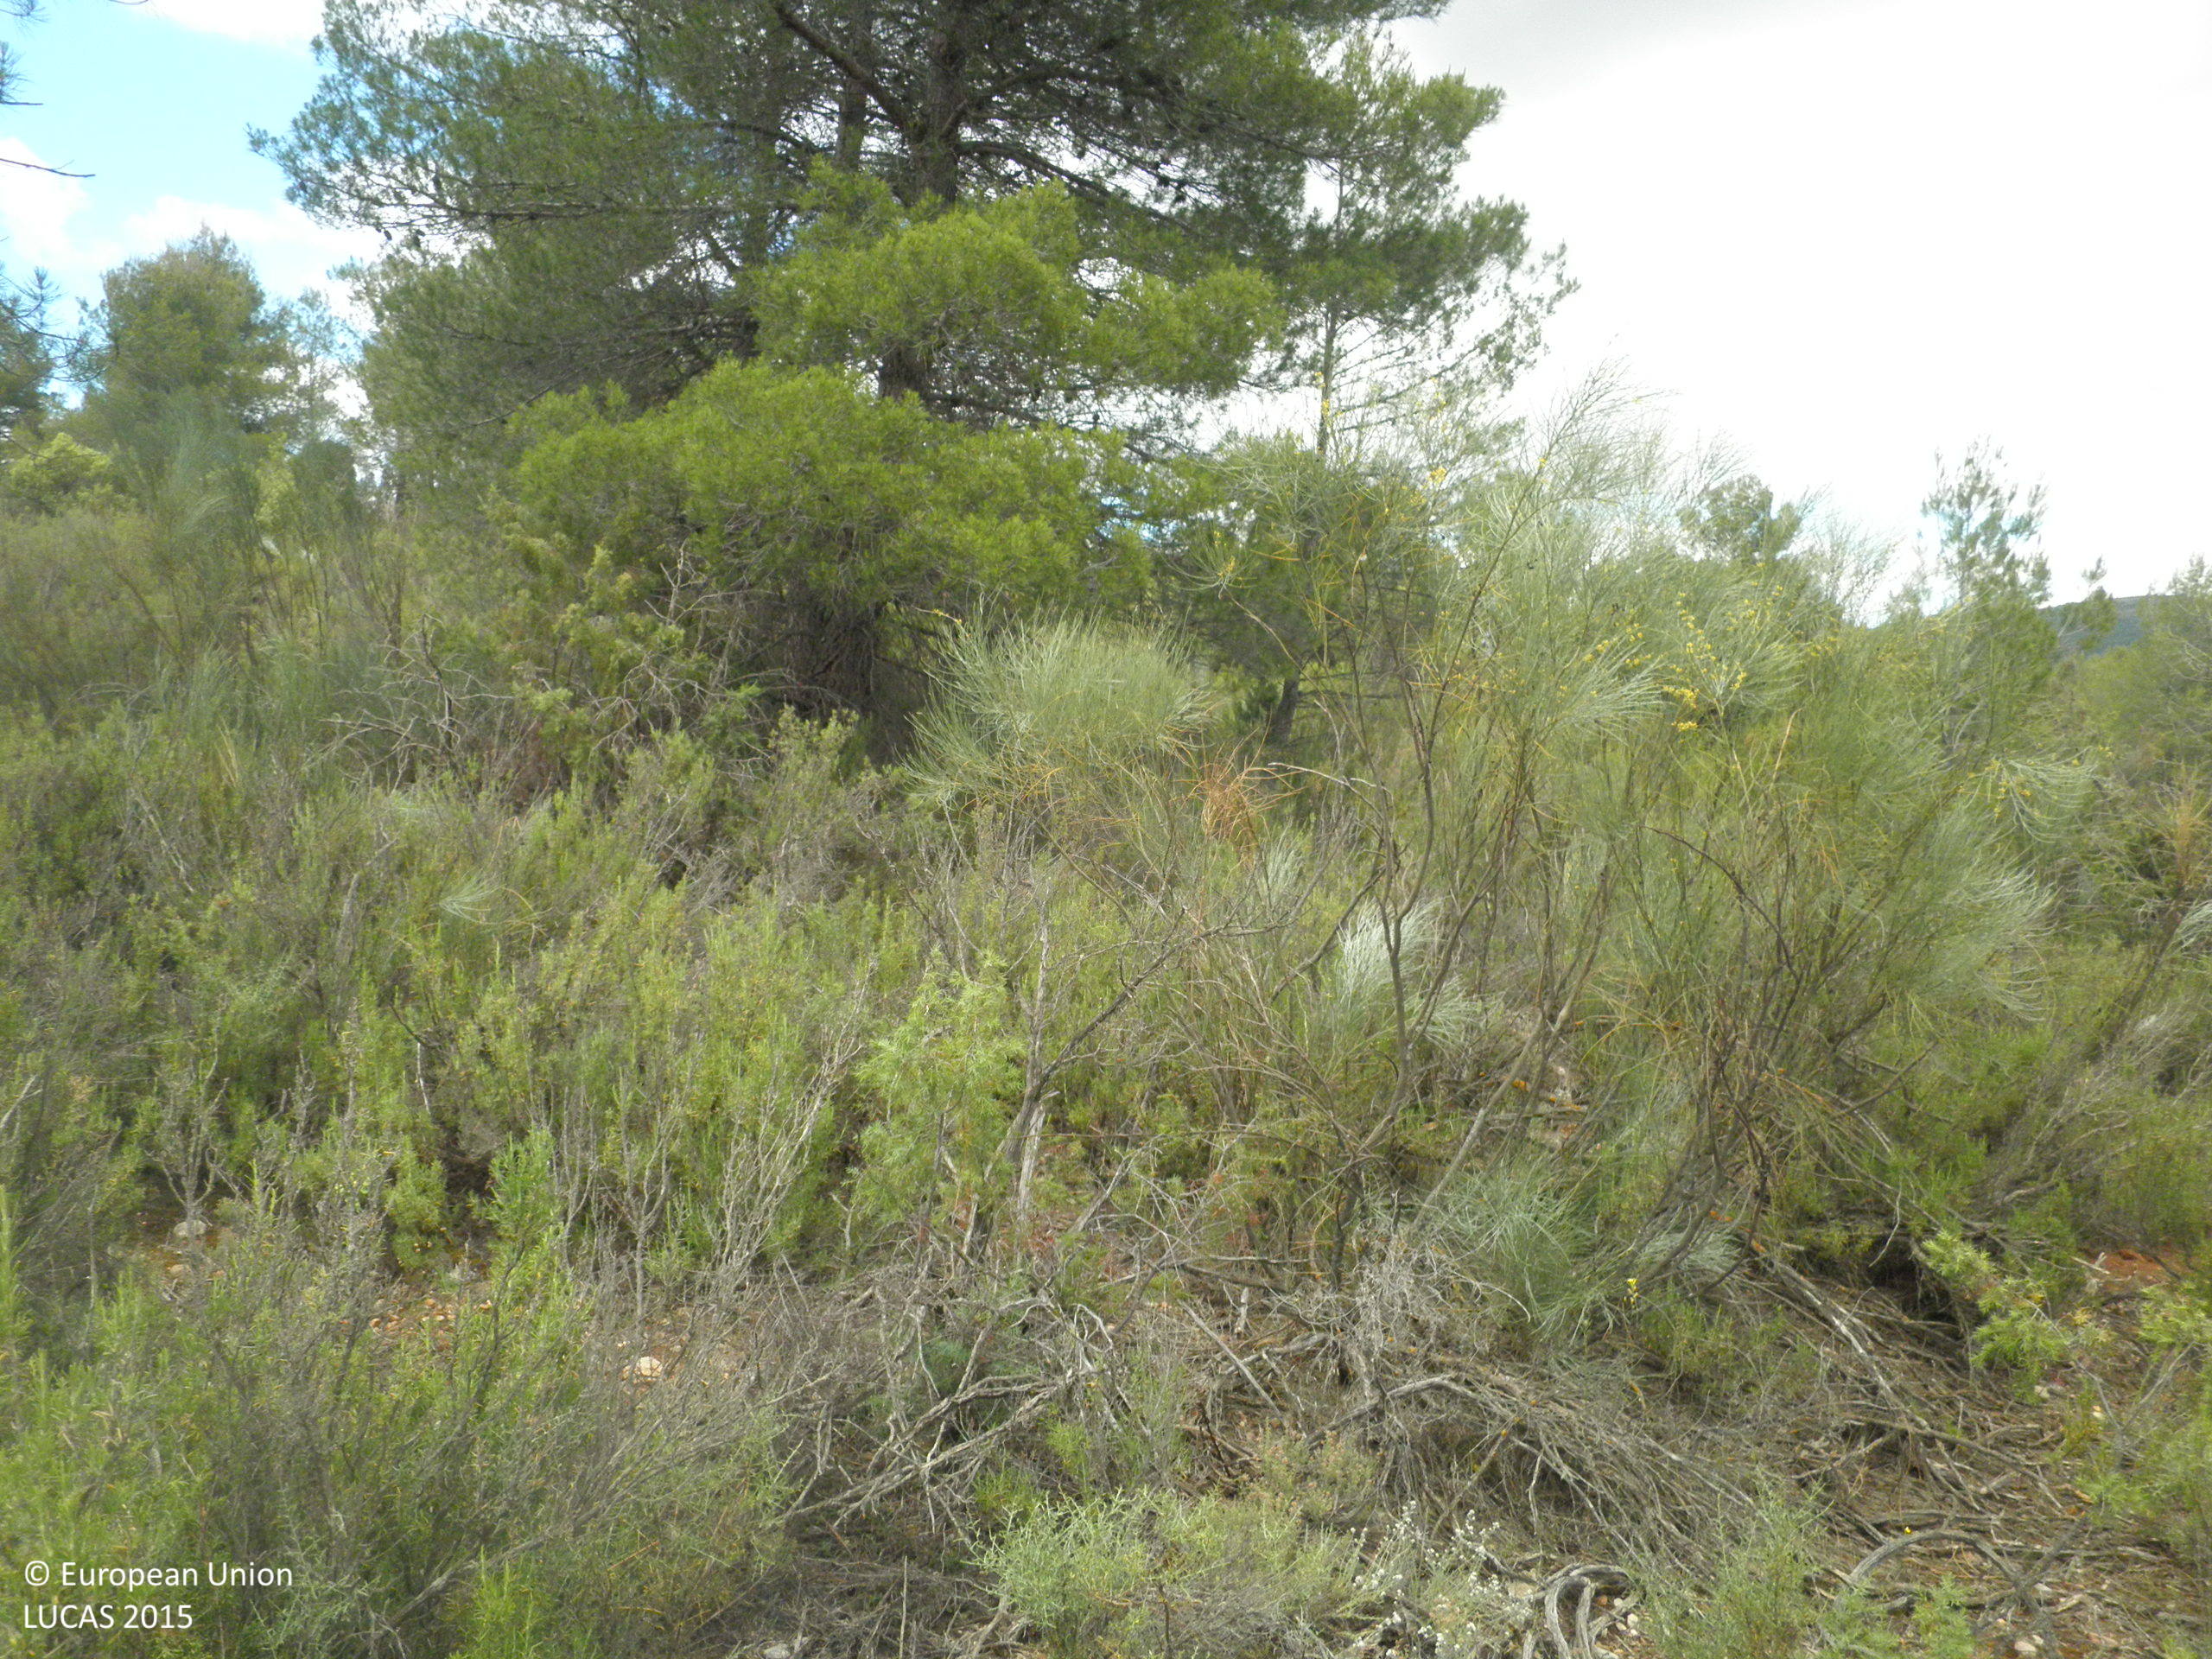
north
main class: Woodland
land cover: Pine dominated coniferous woodland
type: coniferous forest of the mediterranean region
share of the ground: 10 - 25 %
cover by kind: shrubs 75 %, coniferous forest trees 15 %, unconsolidated bare surface 10 %
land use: Semi-natural and natural areas not in use
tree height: > 5 m
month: June
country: ES
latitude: 39.7390
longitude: -1.6183
